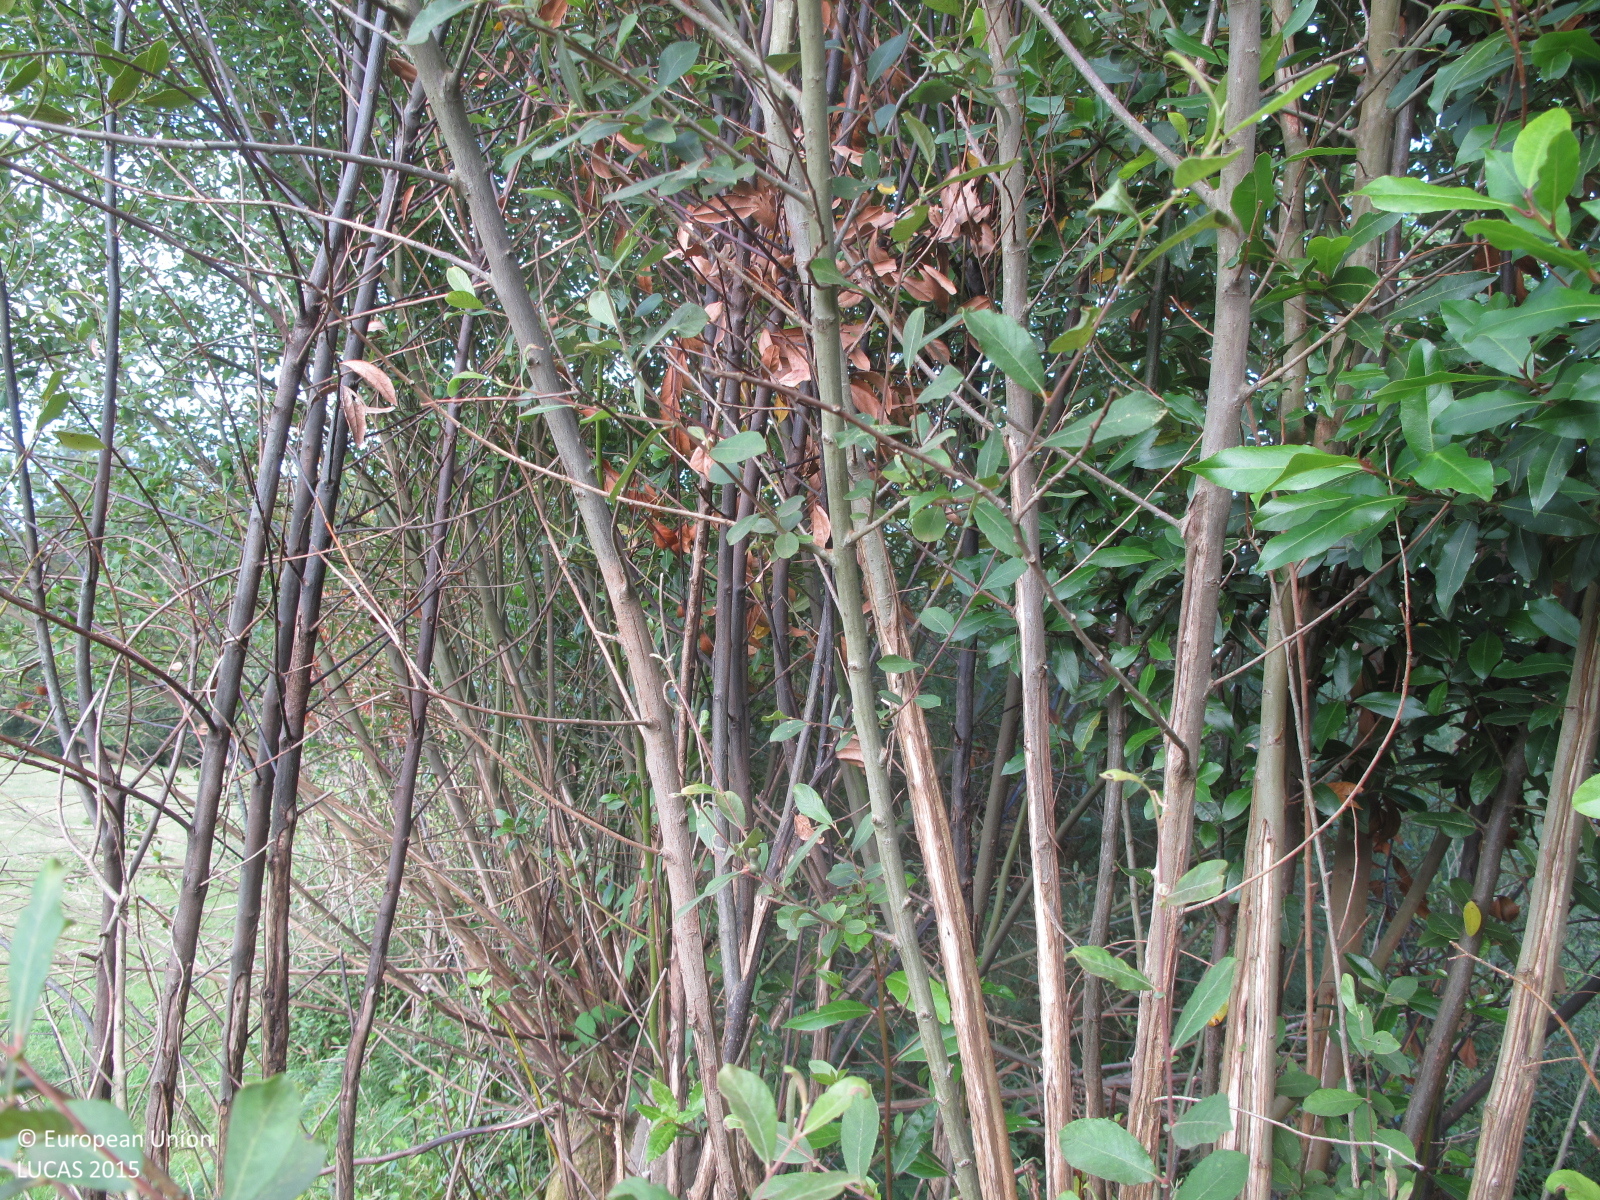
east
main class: Woodland
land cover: Pine dominated mixed woodland
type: exotic forest
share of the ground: 50 - 75 %
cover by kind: coniferous forest trees 40 %, shrubs 40 %, broadleaved forest trees 20 %
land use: Forestry
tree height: > 5 m
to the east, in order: Pine dominated mixed woodland; Fences; Grassland without tree/shrub cover; Broadleaved woodland; Fences; Grassland with sparse tree/shrub cover; Fences; Grassland without tree/shrub cover; Fences; Grassland without tree/shrub cover
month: July
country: ES
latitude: 43.5697
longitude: -8.0137
